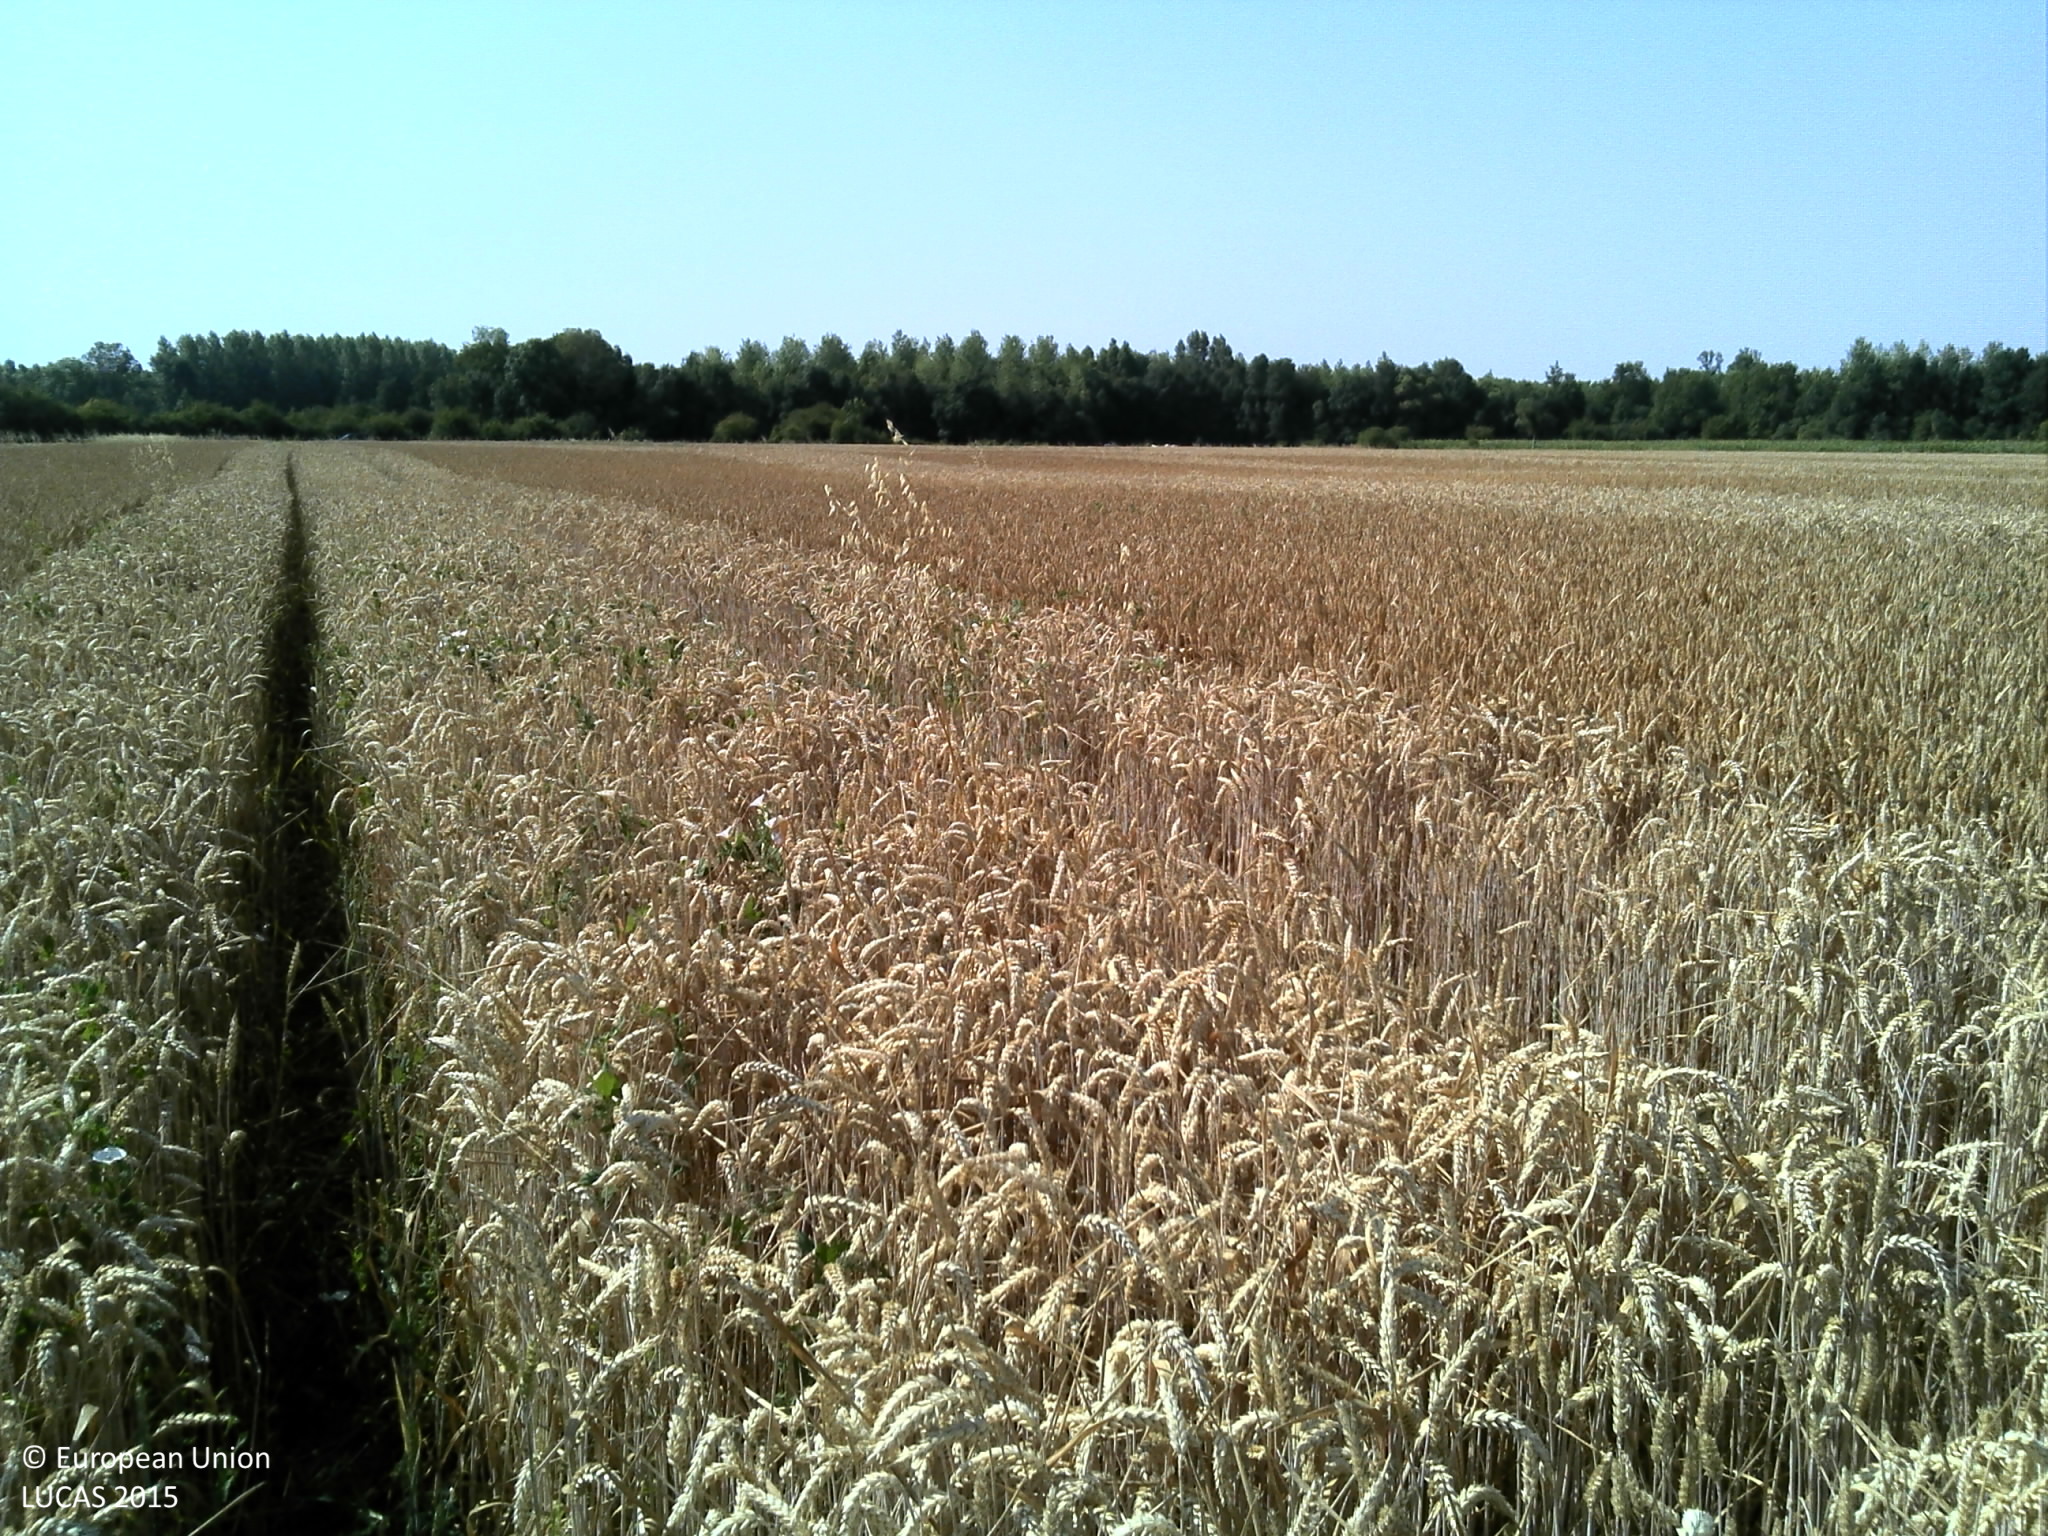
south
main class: Cropland
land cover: Common wheat
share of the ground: > 75 %
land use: Agriculture (excluding fallow land and kitchen gardens)
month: July
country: FR
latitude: 48.7878
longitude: 4.8392
